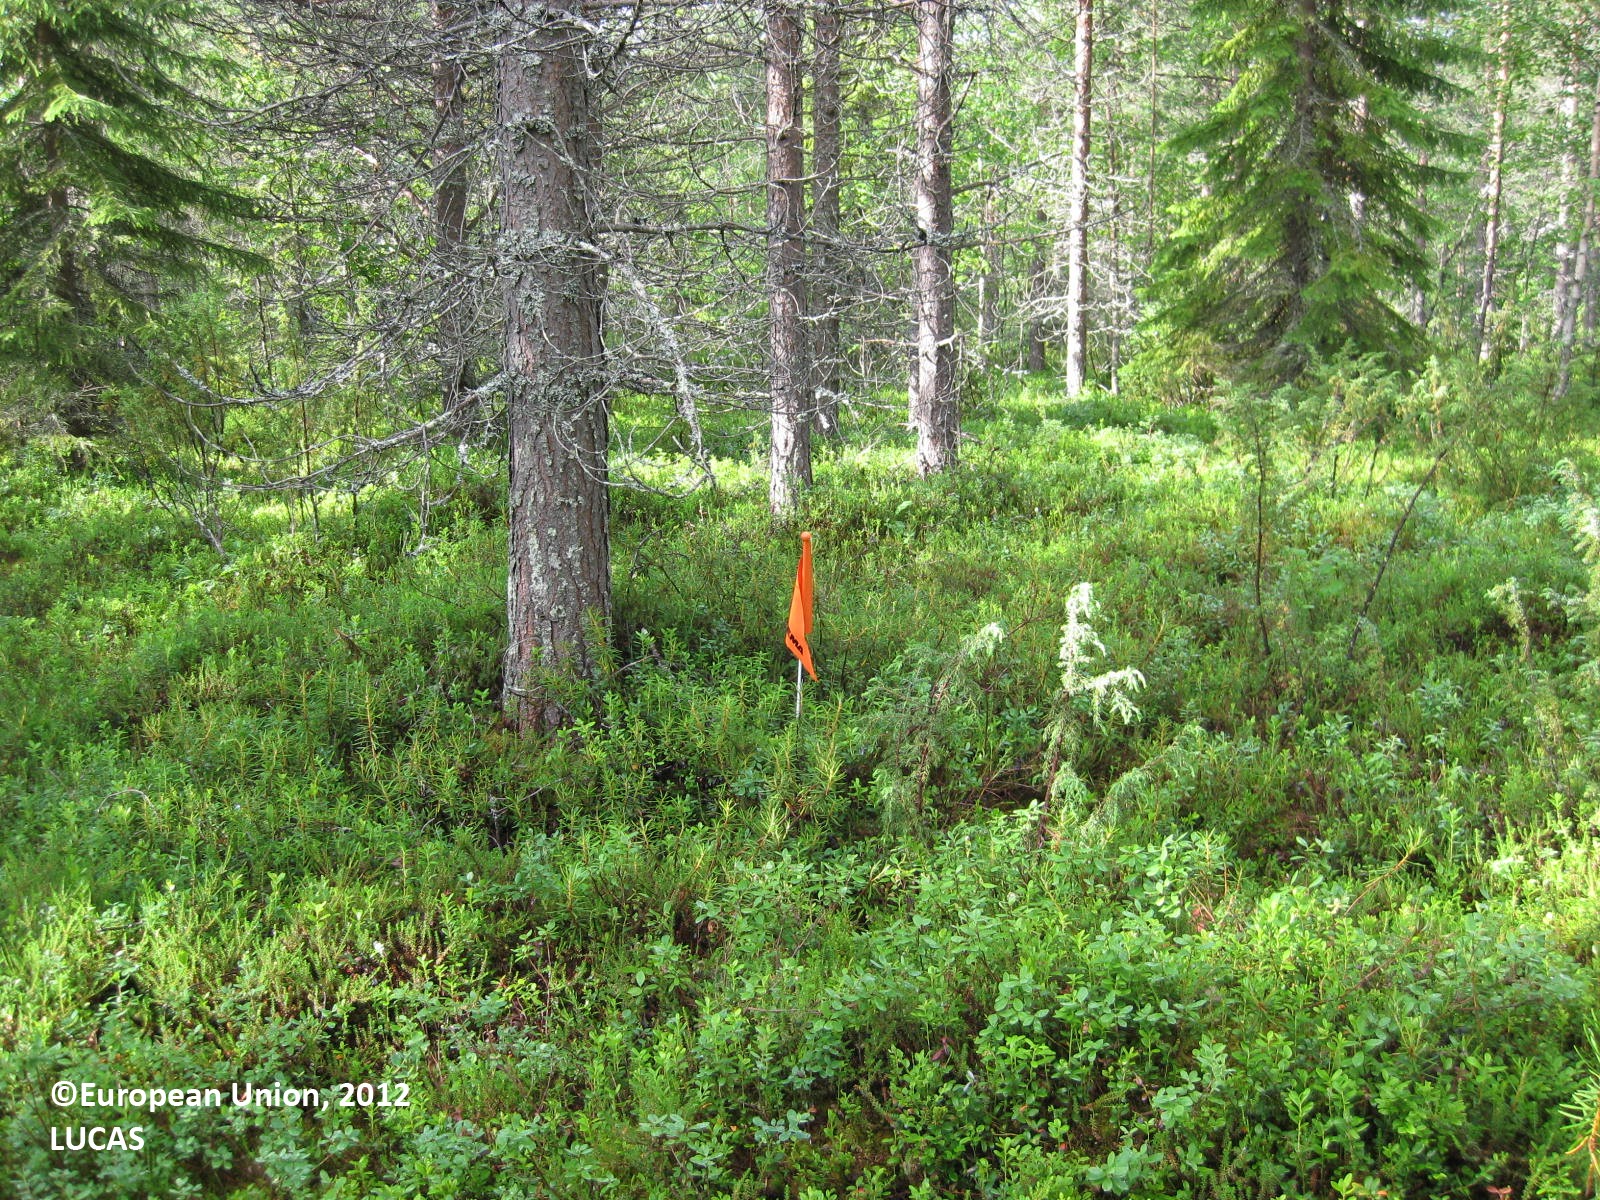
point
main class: Woodland
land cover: Pine dominated mixed woodland
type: boreal forest
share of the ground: > 75 %
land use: Forestry
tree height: > 5 m
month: July
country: FI
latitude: 65.6924
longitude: 29.4163
